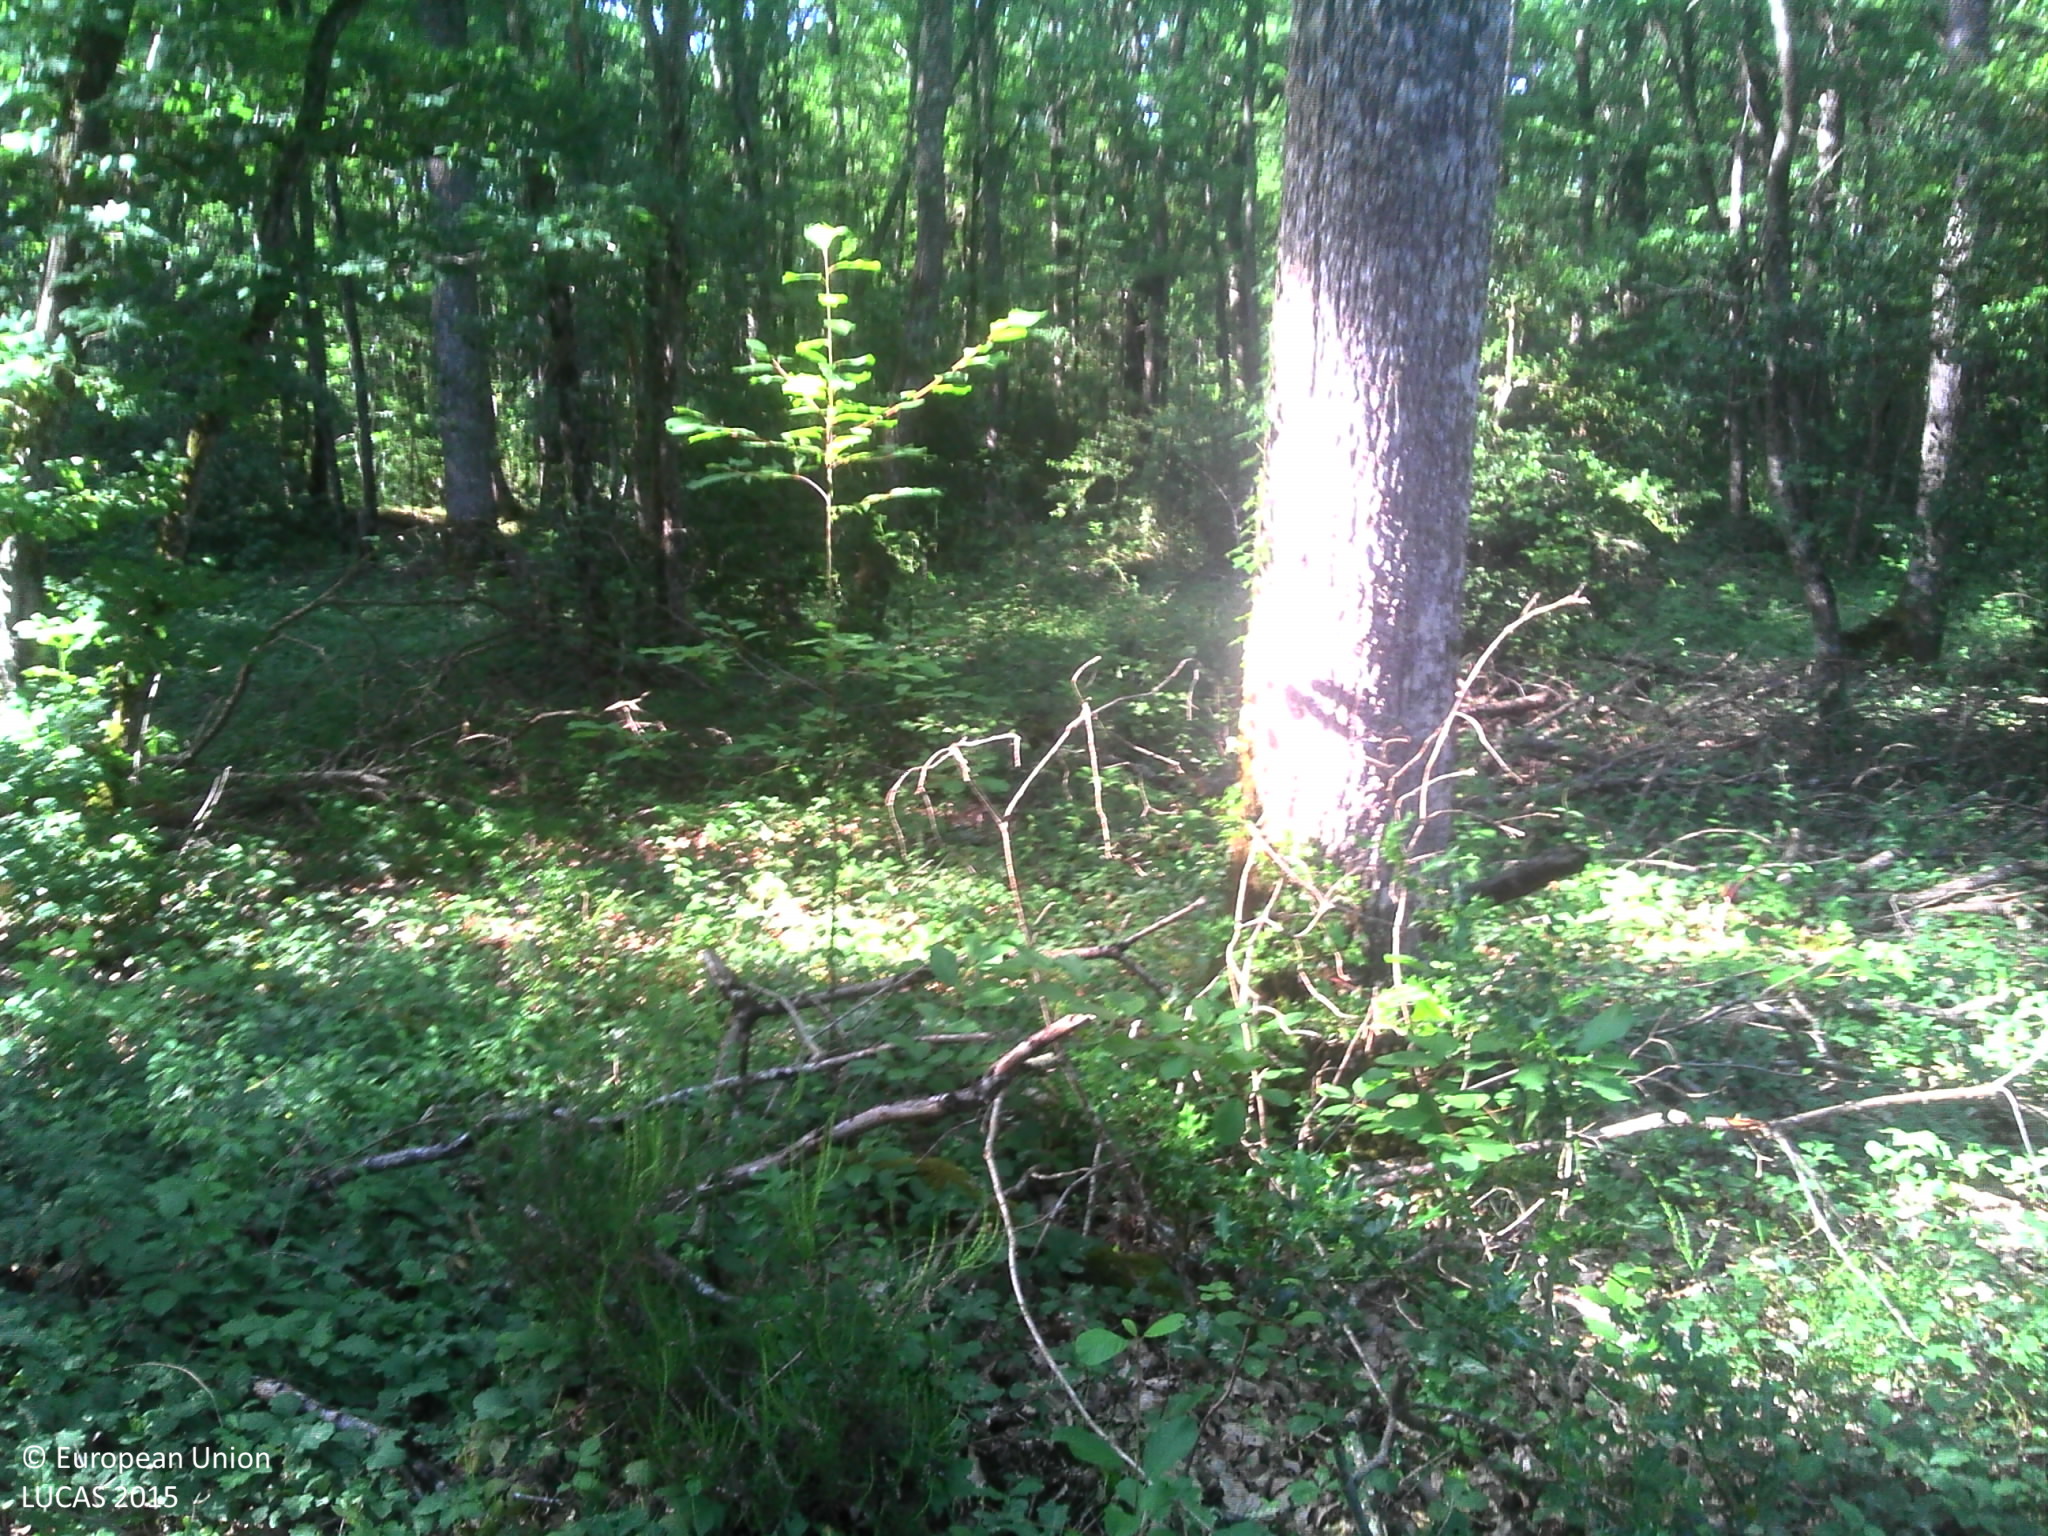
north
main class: Woodland
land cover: Broadleaved woodland
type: mesophytic deciduous forest
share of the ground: > 75 %
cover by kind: herbaceous plants 50 %, unconsolidated bare surface 30 %, broadleaved forest trees 20 %
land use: Forestry
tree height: > 5 m
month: June
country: FR
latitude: 47.3804
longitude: 1.1762
